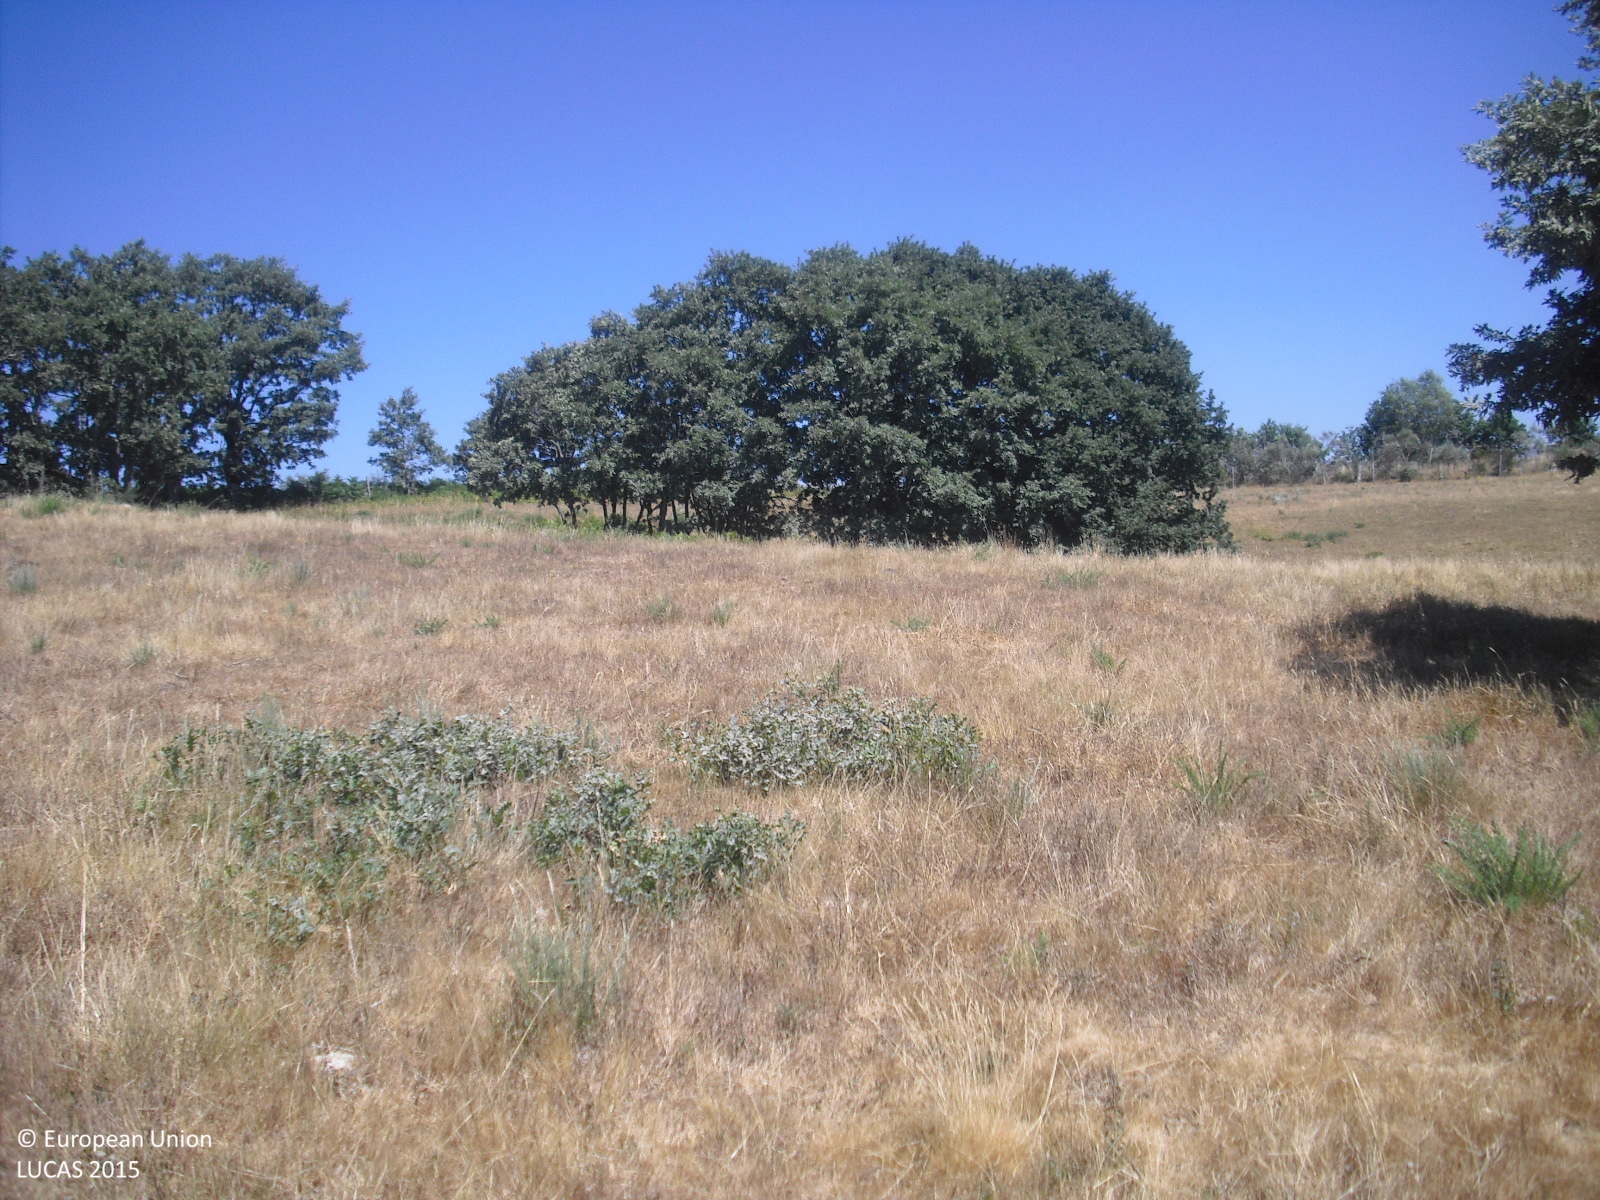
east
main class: Grassland
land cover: Grassland with sparse tree/shrub cover
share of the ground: > 75 %
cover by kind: herbaceous plants 90 %, broadleaved forest trees 5 %, shrubs 5 %
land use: Agriculture (excluding fallow land and kitchen gardens)
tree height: > 5 m
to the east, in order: Grassland with sparse tree/shrub cover; Rock outcrops; Broadleaved woodland; Grassland with sparse tree/shrub cover; Fences; Dry stone walls; Shrubland with sparse tree cover; Tracks; Shrubland without tree cover; Grass margins; Ditches and canals; Paved roads, cycling and walking lanes; Ditches and canals; Shruby margins; Fences; Dry stone walls; Grassland with sparse tree/shrub cover
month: July
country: ES
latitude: 42.2703
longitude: -7.4385
